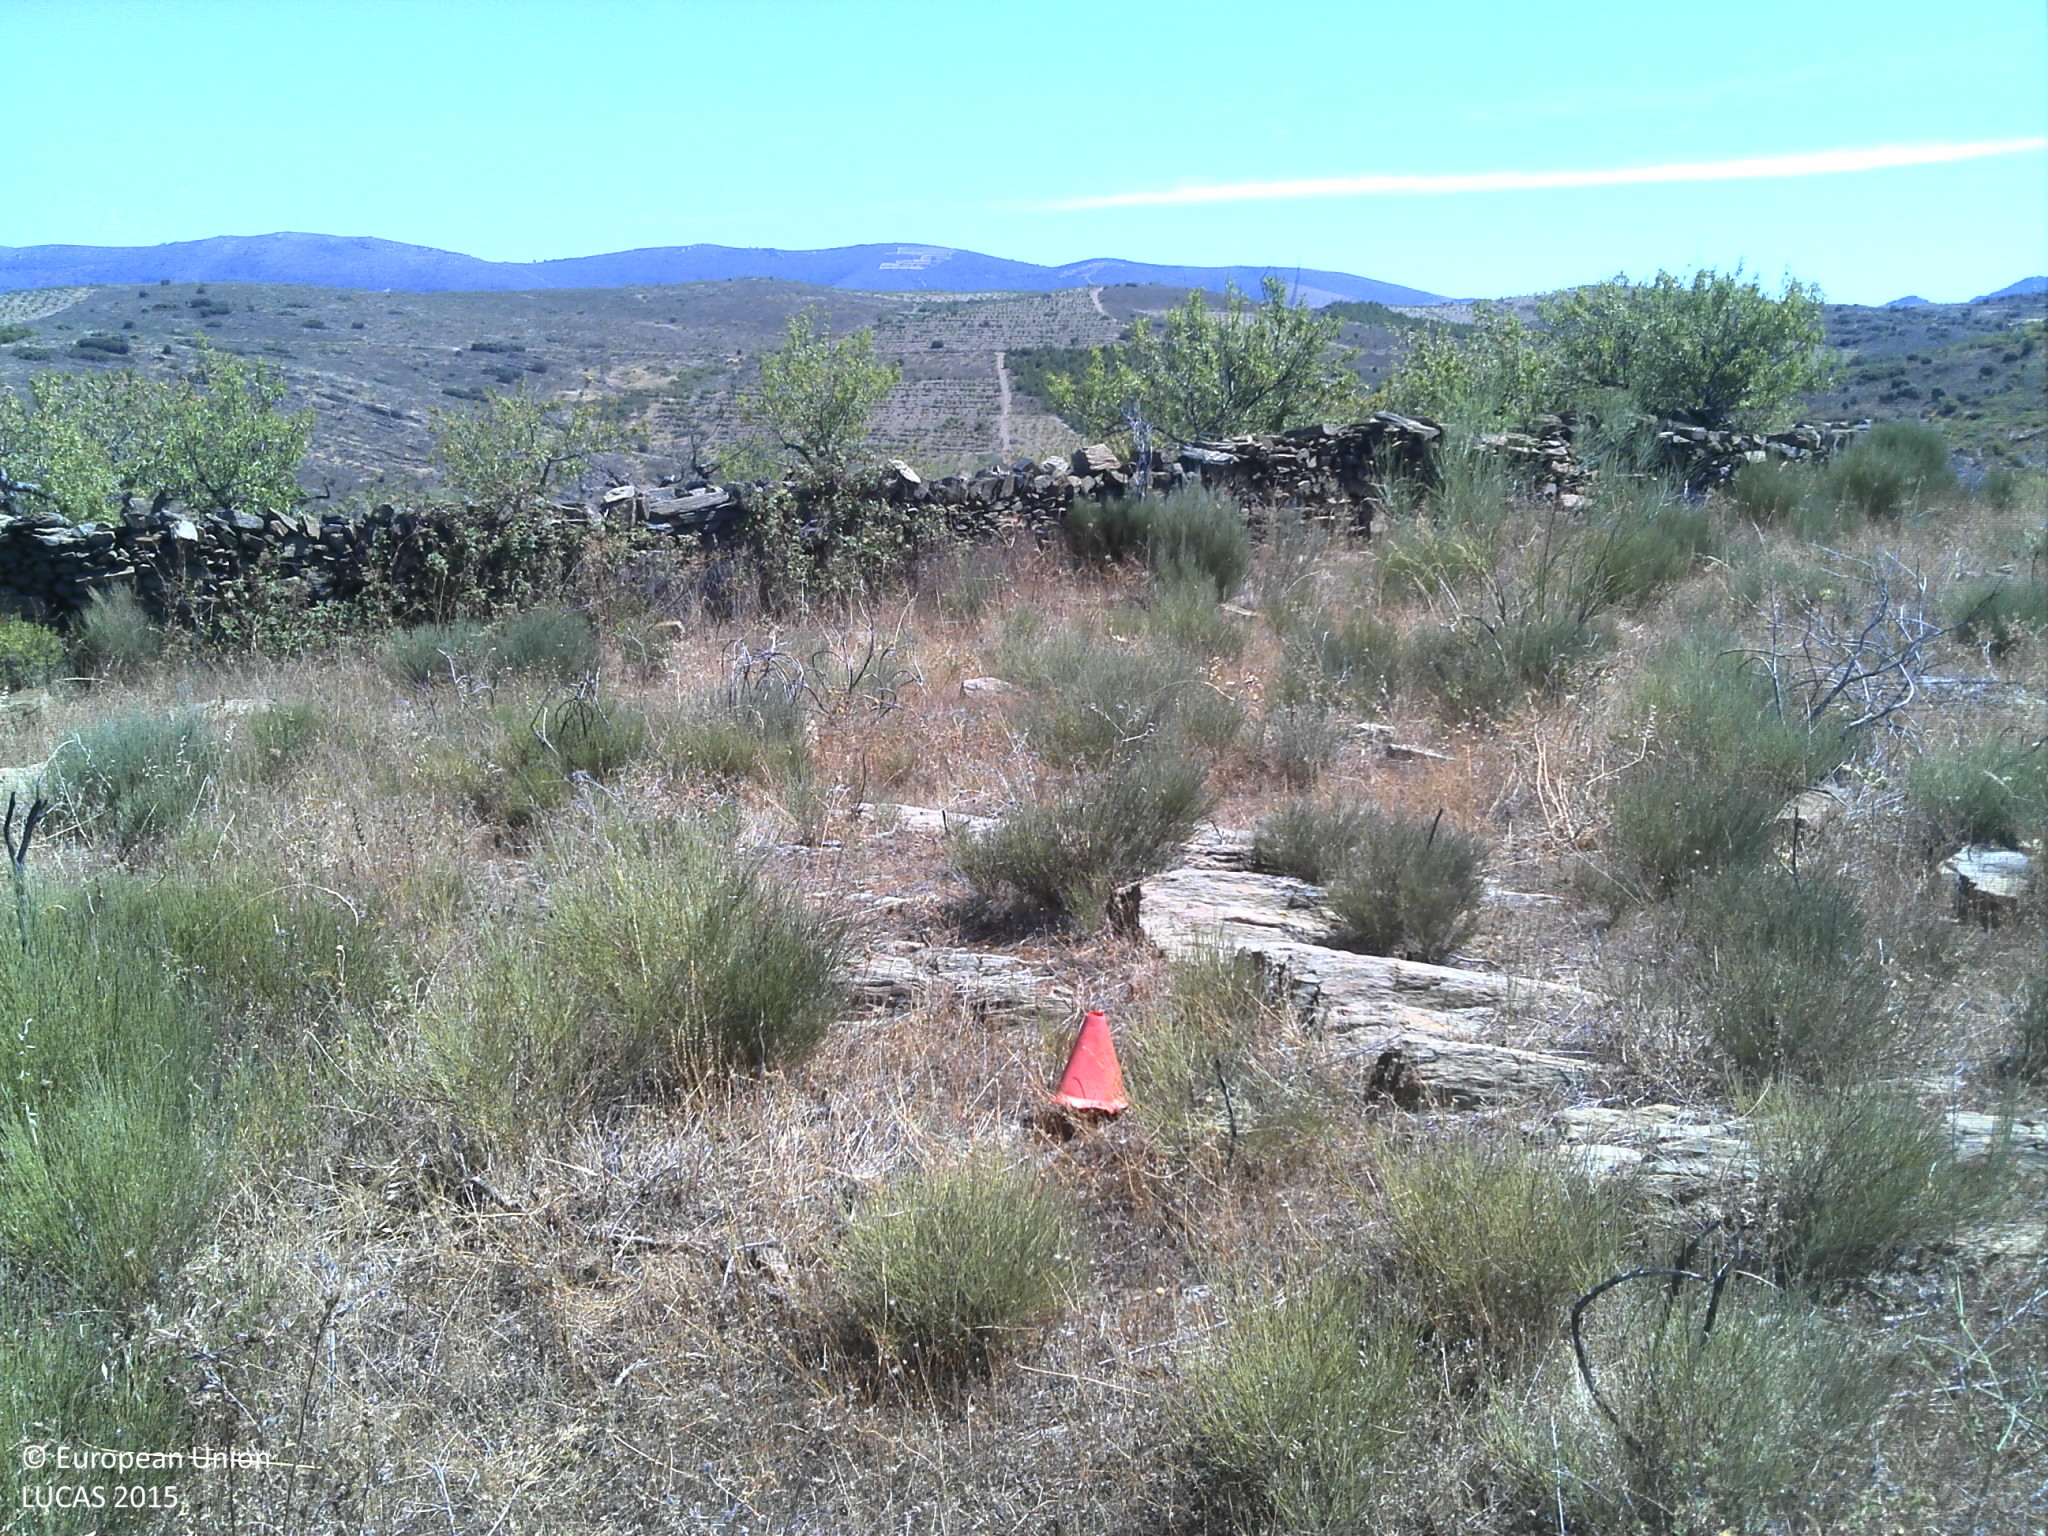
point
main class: Shrubland
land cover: Shrubland without tree cover
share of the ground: 50 - 75 %
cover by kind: shrubs 75 %, herbaceous plants 20 %, consolidated bare surface 5 %
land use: Abandoned areas
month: July
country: PT
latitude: 41.0855
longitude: -7.0486
